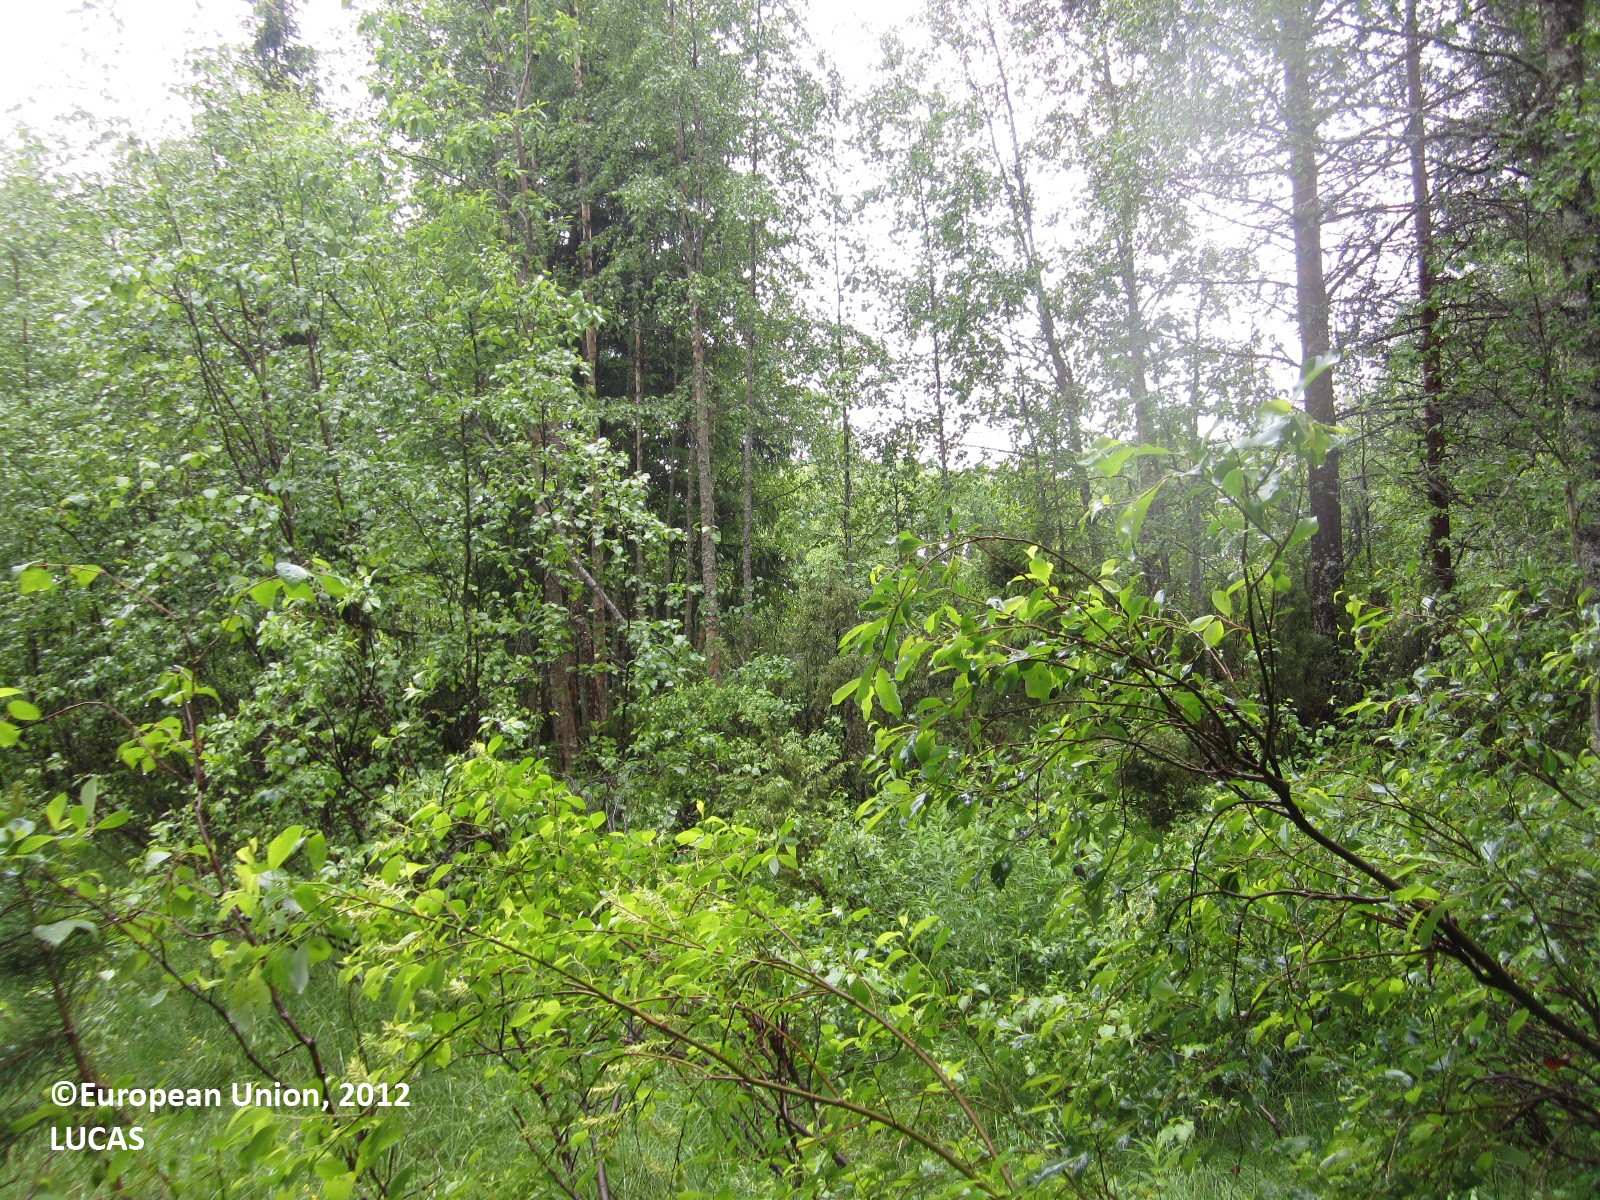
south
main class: Woodland
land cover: Spruce dominated mixed woodland
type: boreal forest
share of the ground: 50 - 75 %
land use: Forestry
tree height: > 5 m
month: June
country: FI
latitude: 64.6120
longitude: 29.9423
